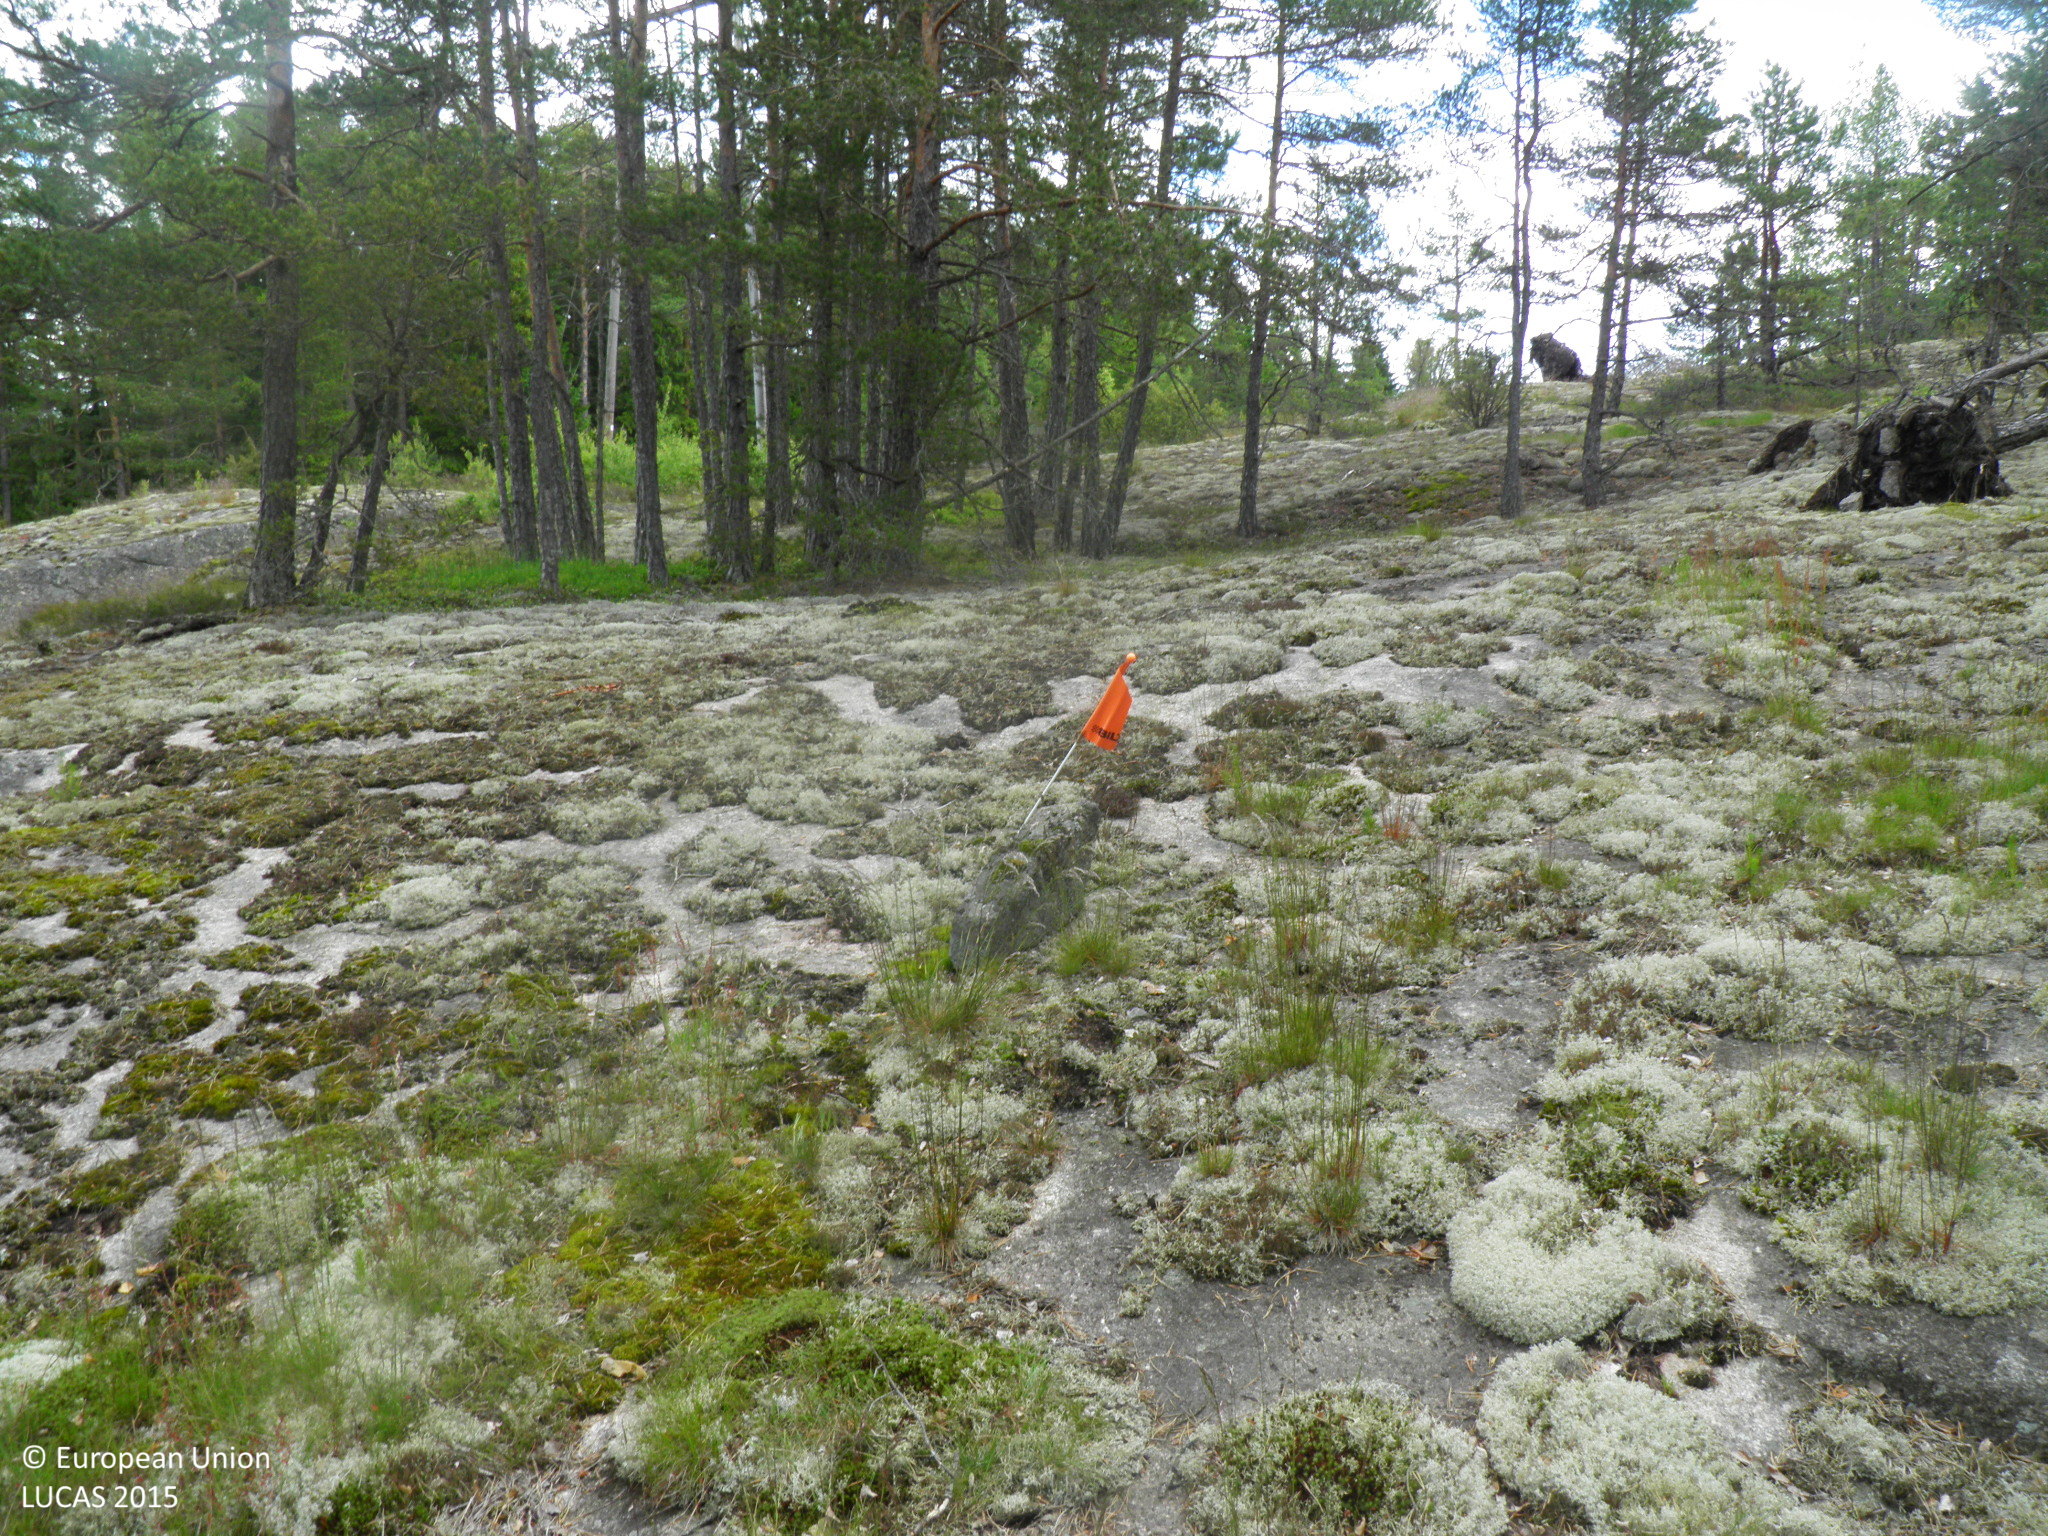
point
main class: Woodland
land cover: Pine dominated coniferous woodland
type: boreal forest
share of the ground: 25 - 50 %
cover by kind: lichens and mosses 40 %, coniferous forest trees 30 %, shrubs 10 %, herbaceous plants 10 %, consolidated bare surface 10 %
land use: Forestry
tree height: > 5 m
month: June
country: FI
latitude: 60.2798
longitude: 22.4946
